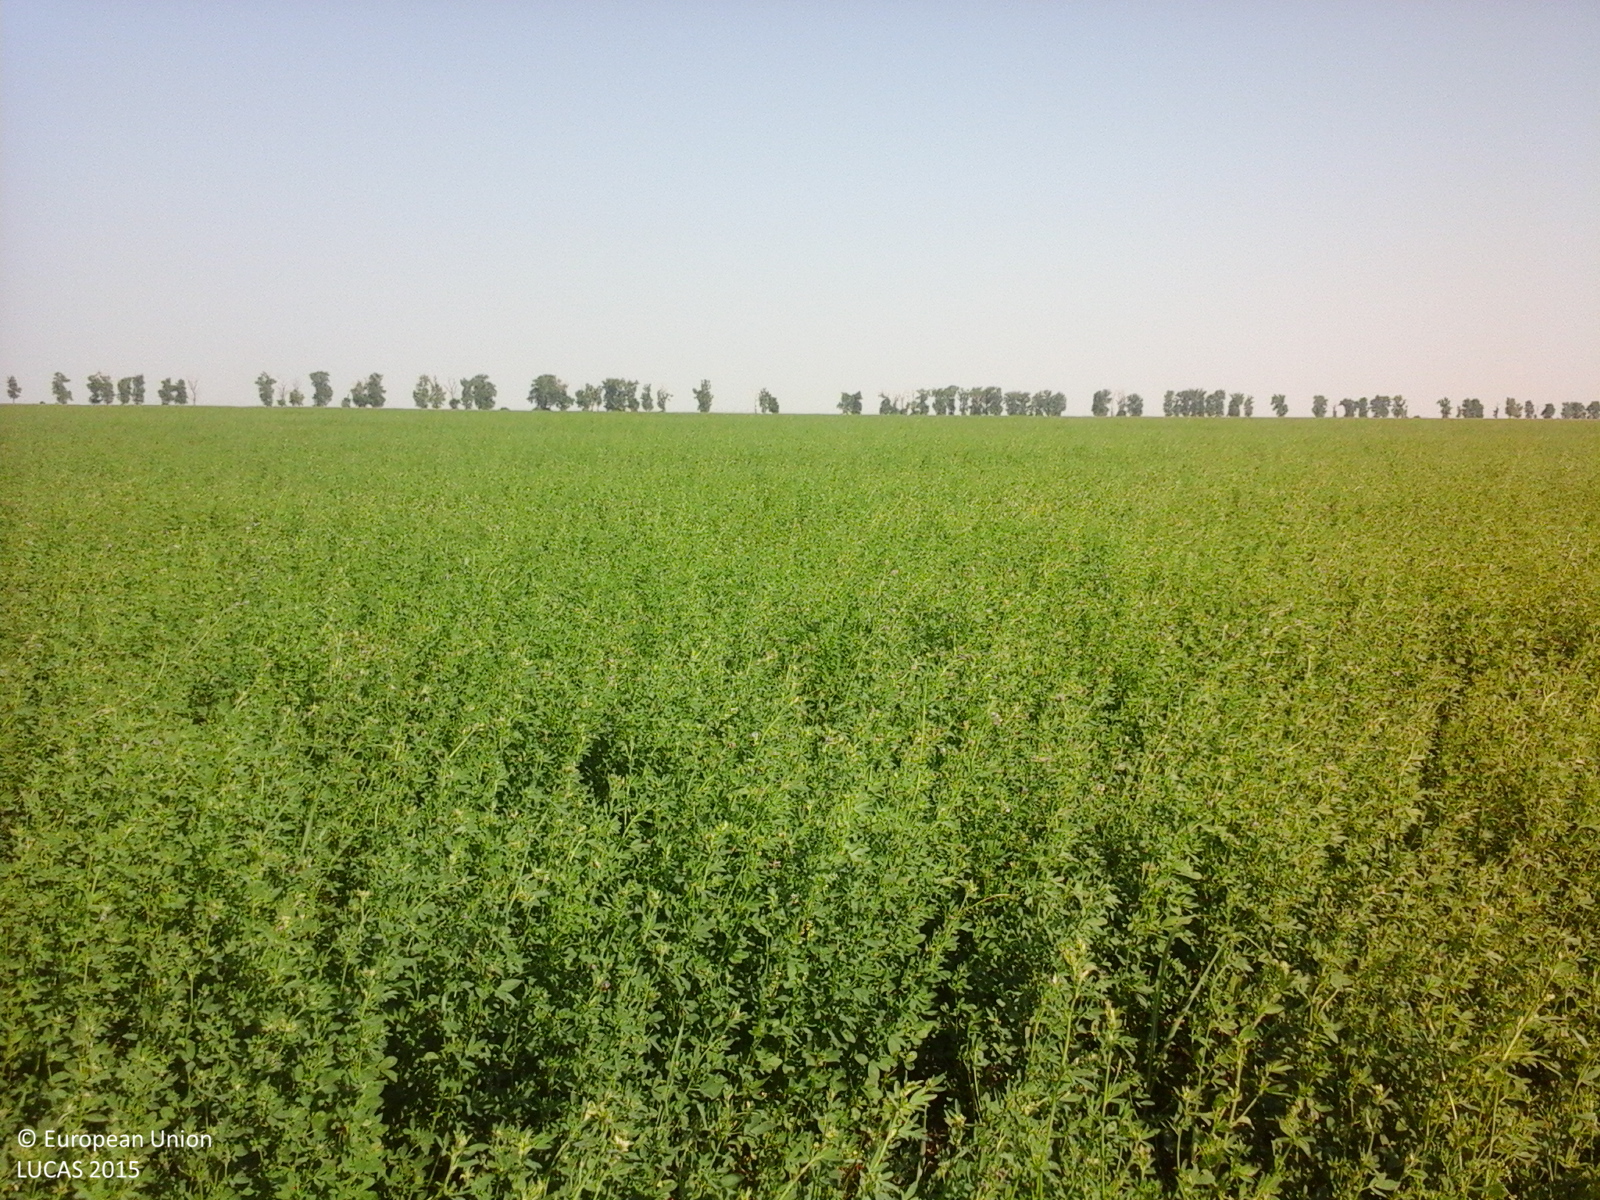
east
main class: Cropland
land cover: Lucerne
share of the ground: > 75 %
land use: Agriculture (excluding fallow land and kitchen gardens)
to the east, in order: Lucerne
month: July
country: RO
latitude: 44.7080
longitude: 27.2925
